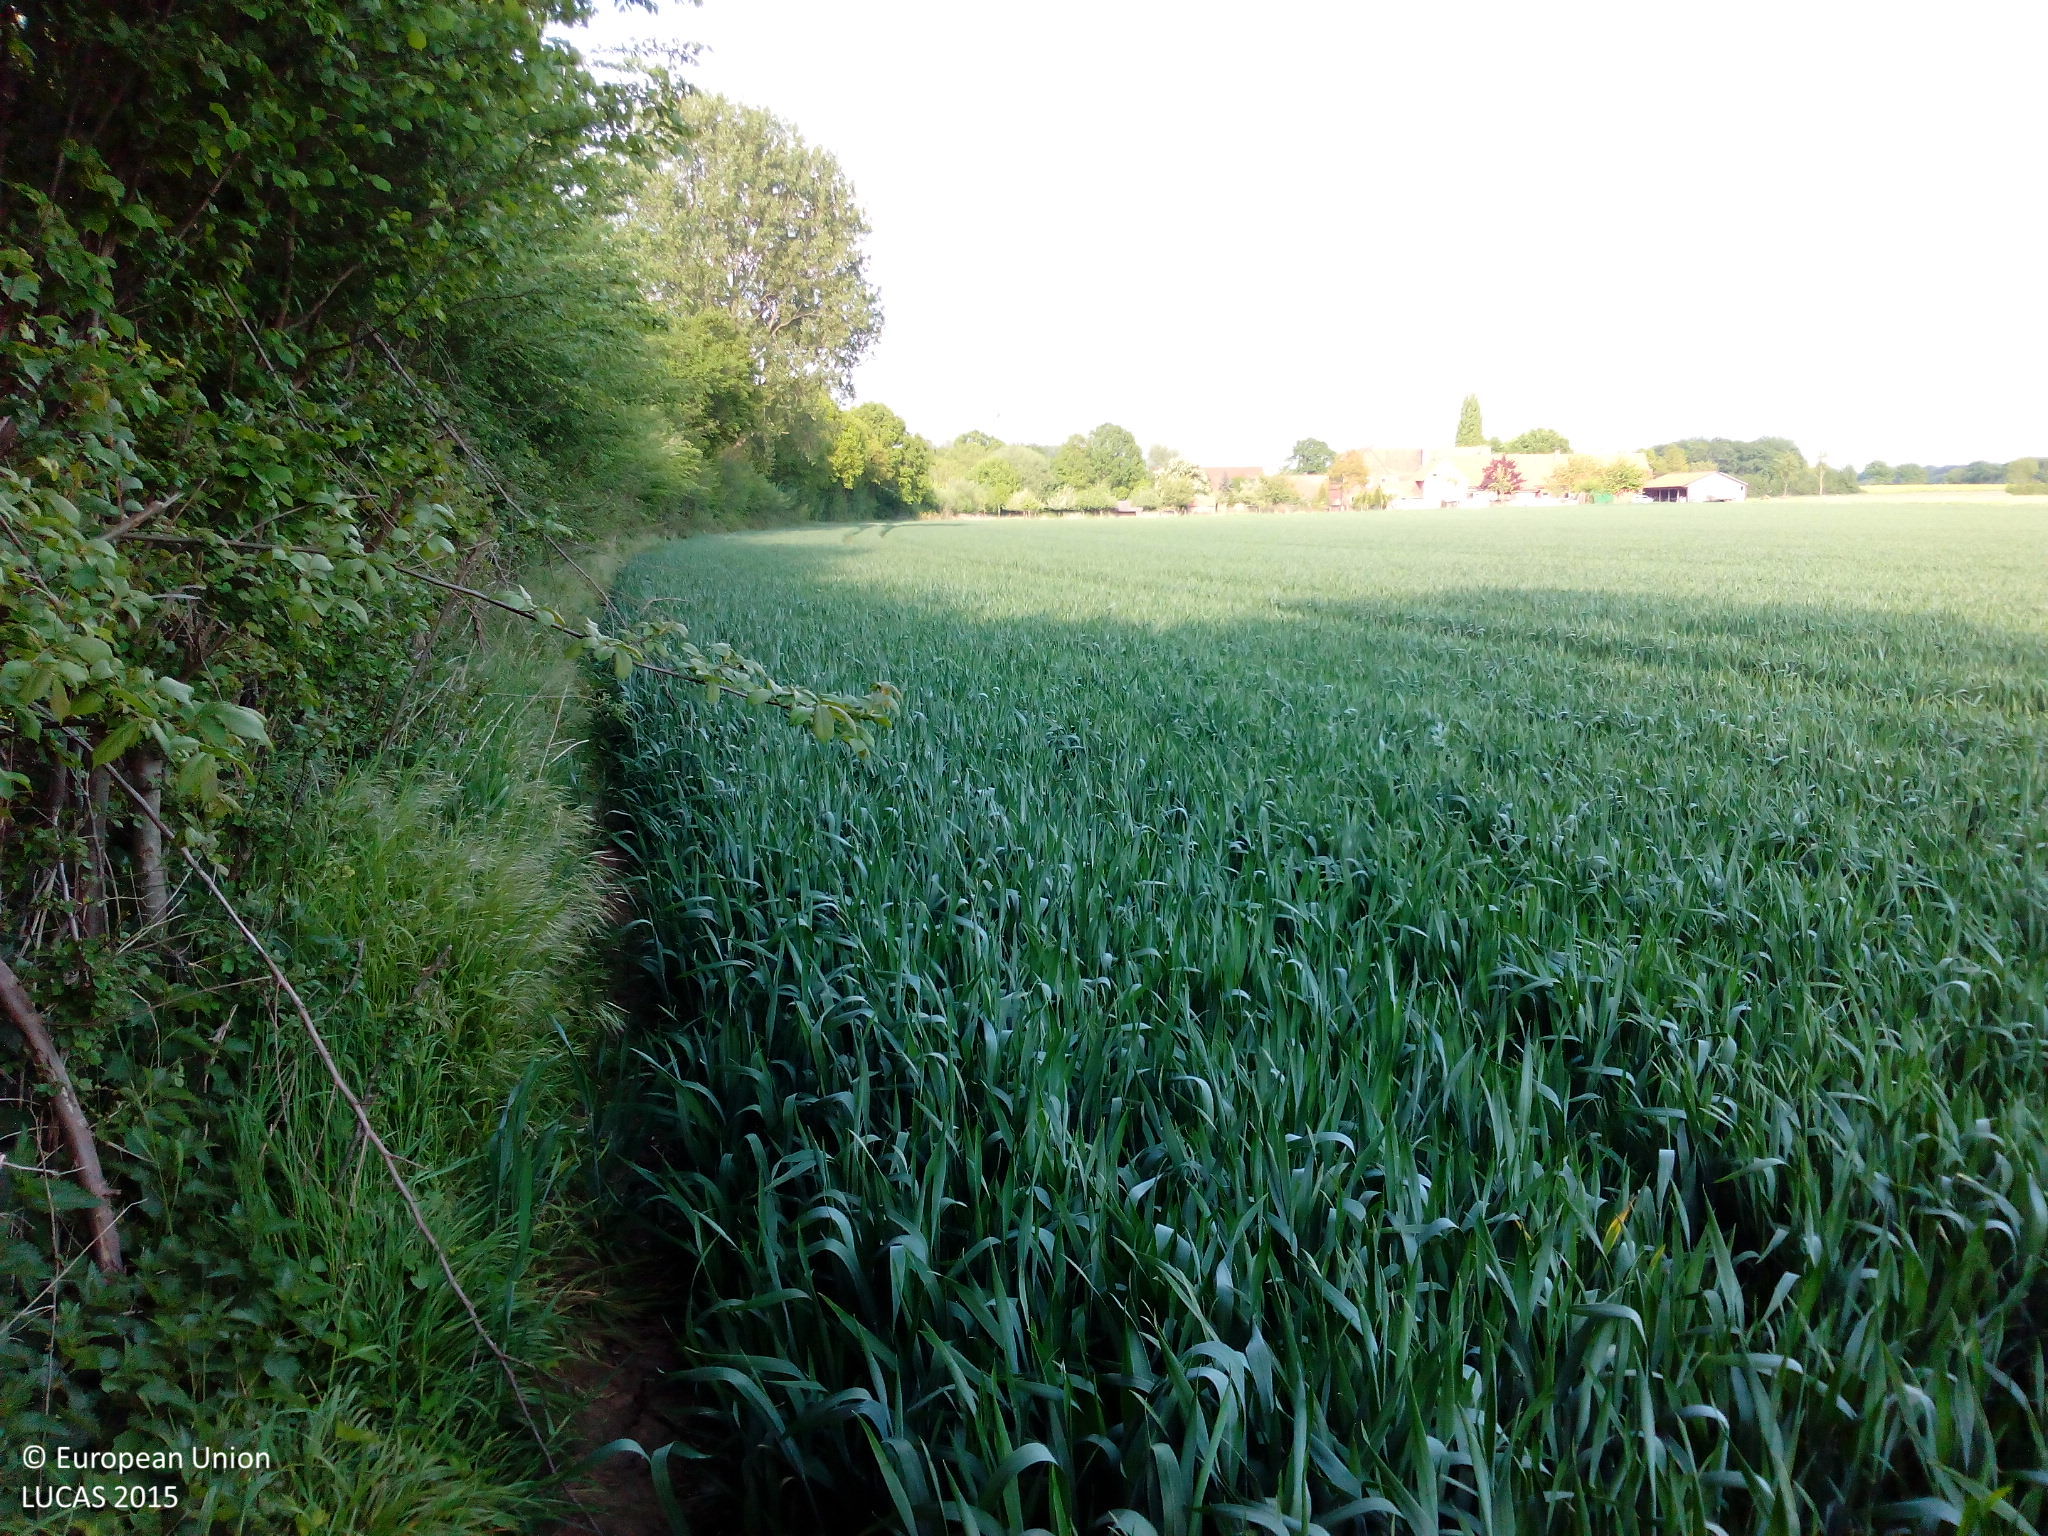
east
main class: Cropland
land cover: Common wheat
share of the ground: > 75 %
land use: Agriculture (excluding fallow land and kitchen gardens)
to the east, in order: Common wheat; Artificial constructions in urban areas
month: May
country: DE
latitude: 51.8564
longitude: 7.9532
